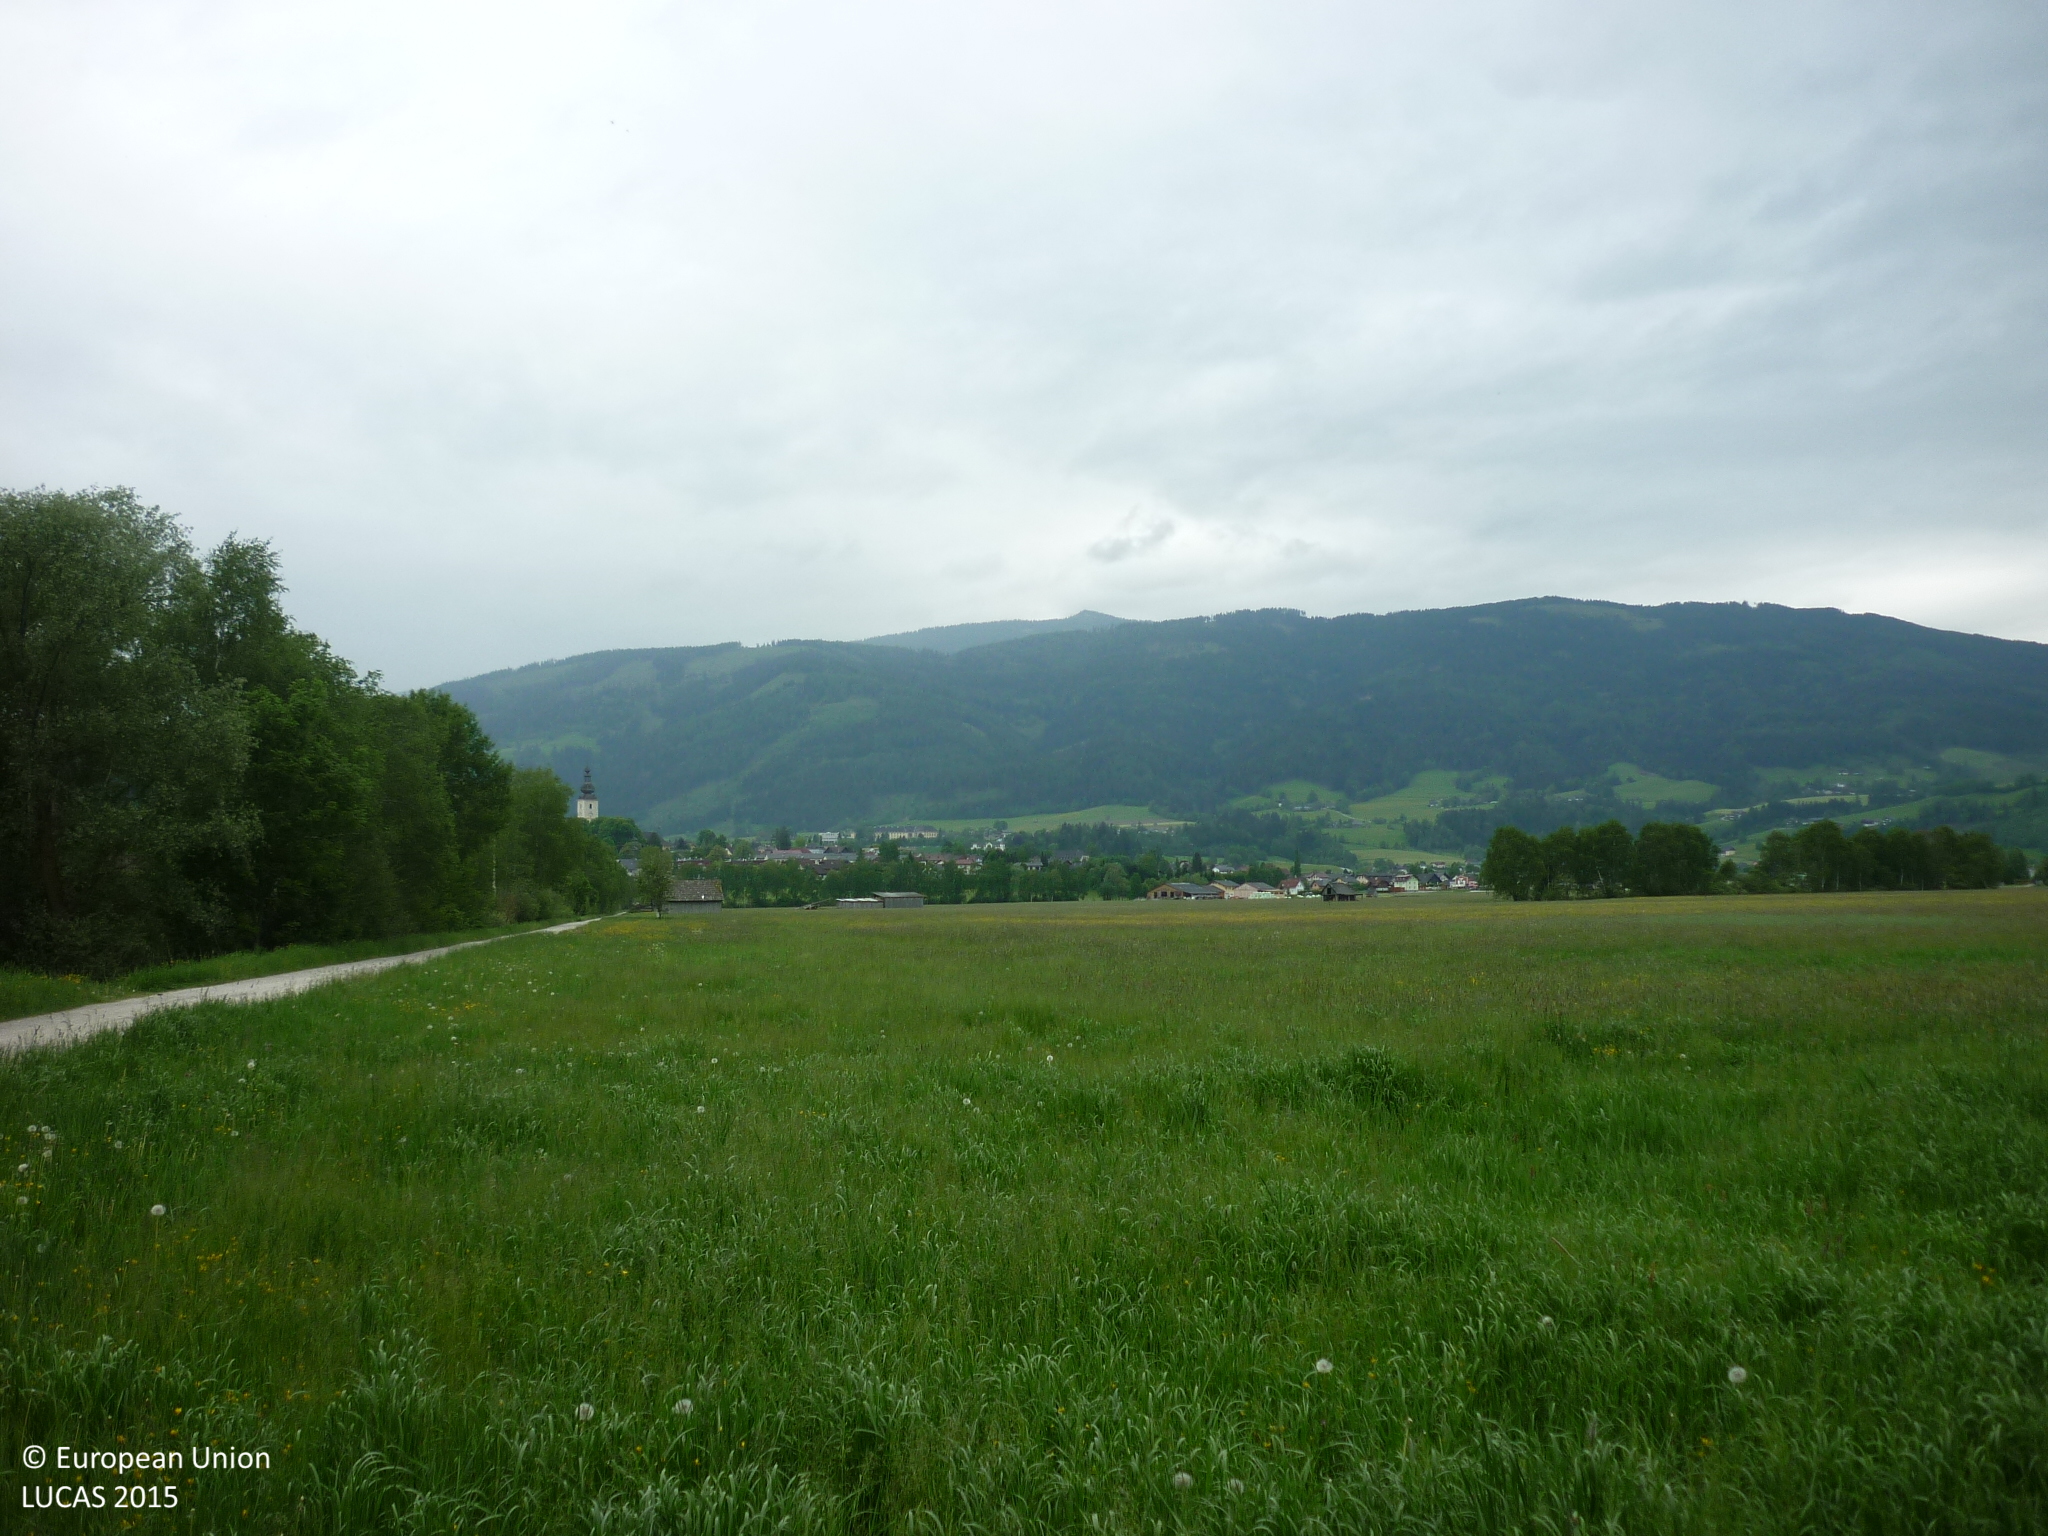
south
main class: Grassland
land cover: Grassland without tree/shrub cover
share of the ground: > 75 %
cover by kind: herbaceous plants 100 %
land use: Agriculture (excluding fallow land and kitchen gardens)
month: May
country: AT
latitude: 47.5165
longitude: 14.1021
